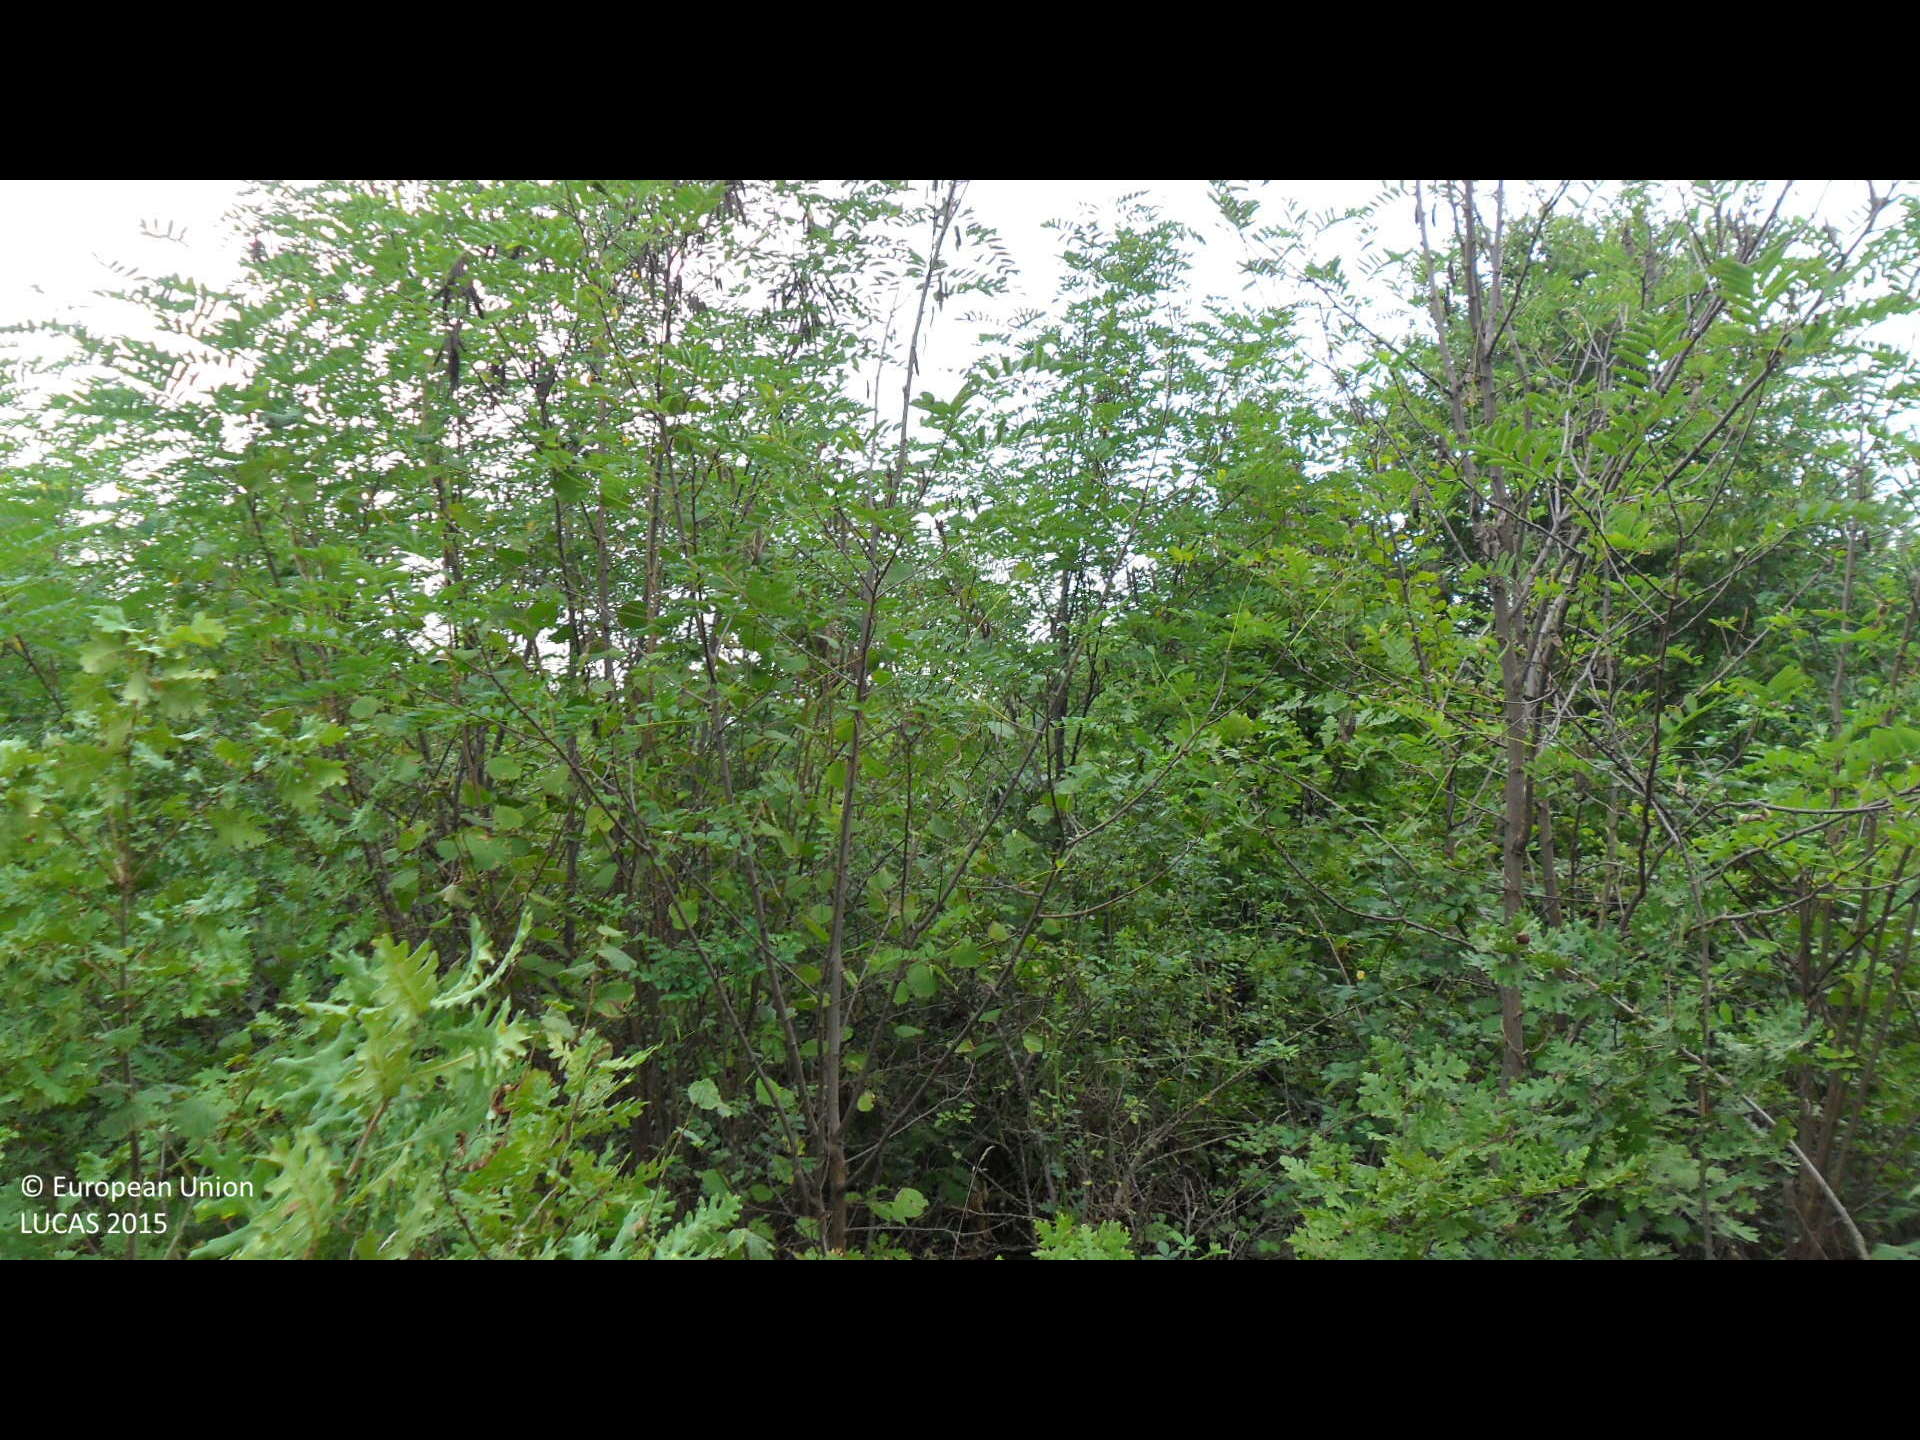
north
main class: Woodland
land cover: Broadleaved woodland
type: mesophytic deciduous forest
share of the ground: > 75 %
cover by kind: broadleaved forest trees 95 %, unconsolidated bare surface 5 %
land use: Forestry
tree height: > 5 m
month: September
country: BG
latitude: 43.1136
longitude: 26.2547
